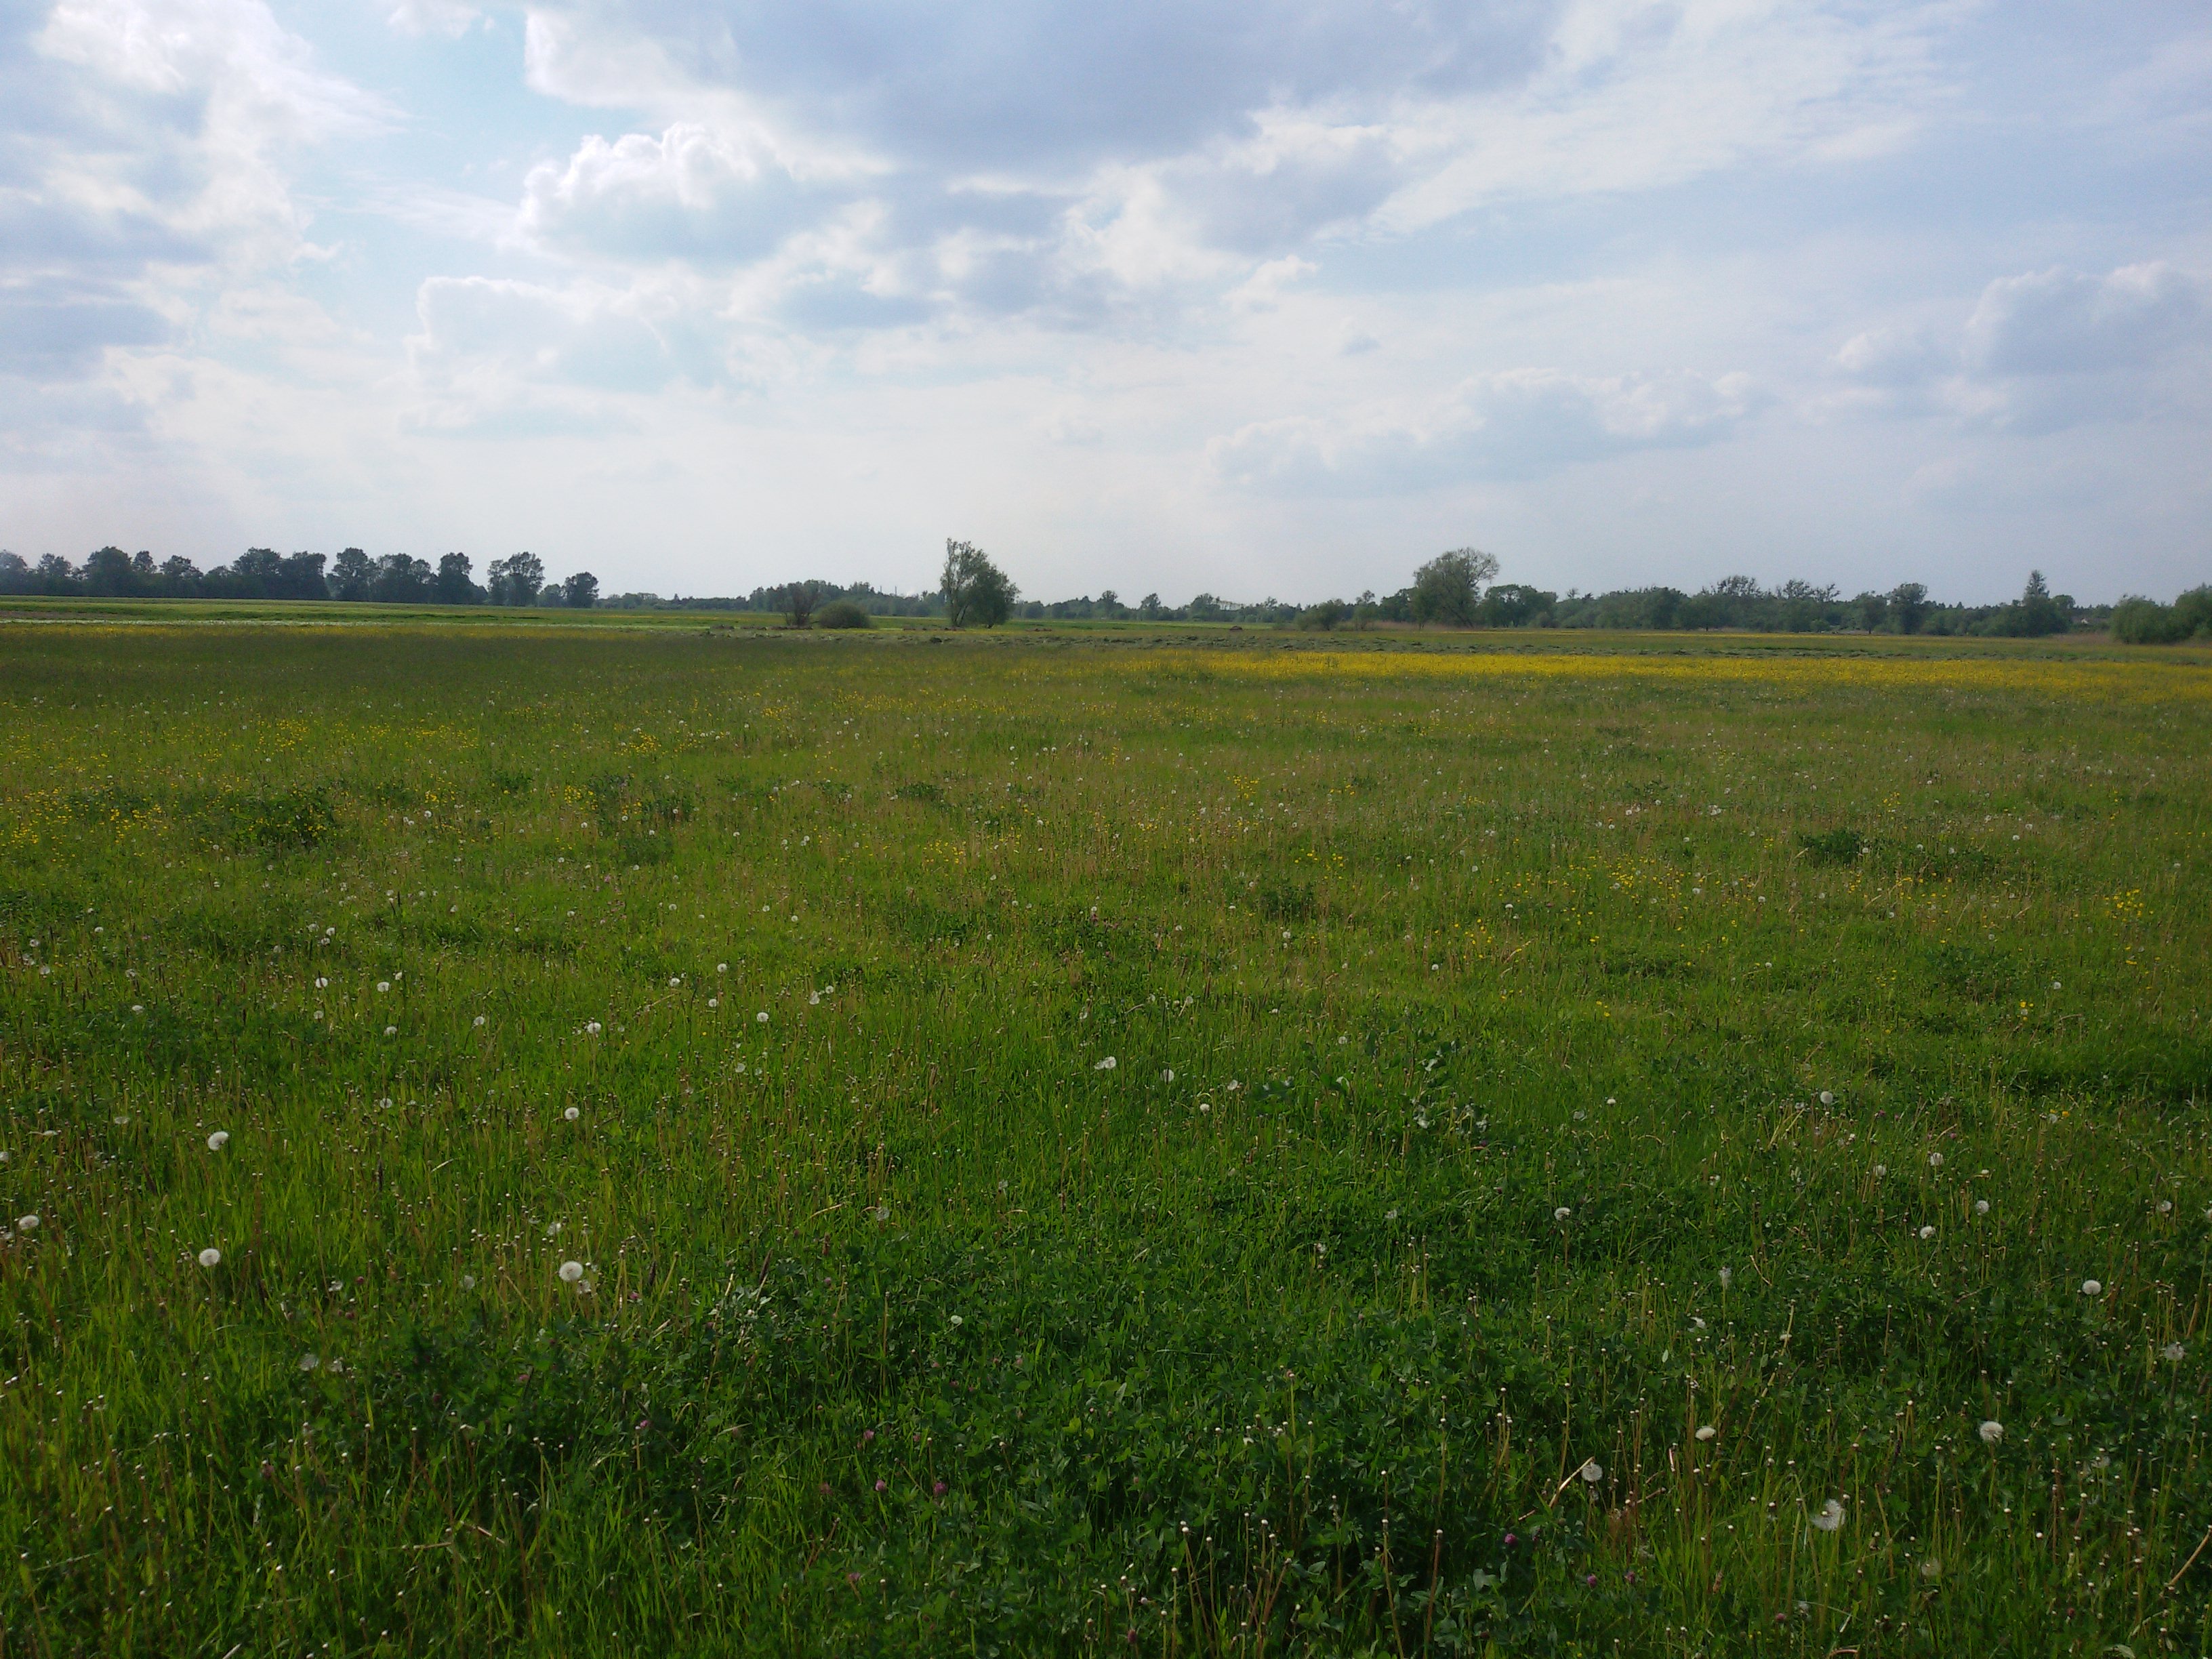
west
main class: Grassland
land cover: Grassland without tree/shrub cover
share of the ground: > 75 %
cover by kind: herbaceous plants 100 %
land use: Agriculture (excluding fallow land and kitchen gardens)
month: May
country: PL
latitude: 51.6197
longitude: 21.6514
